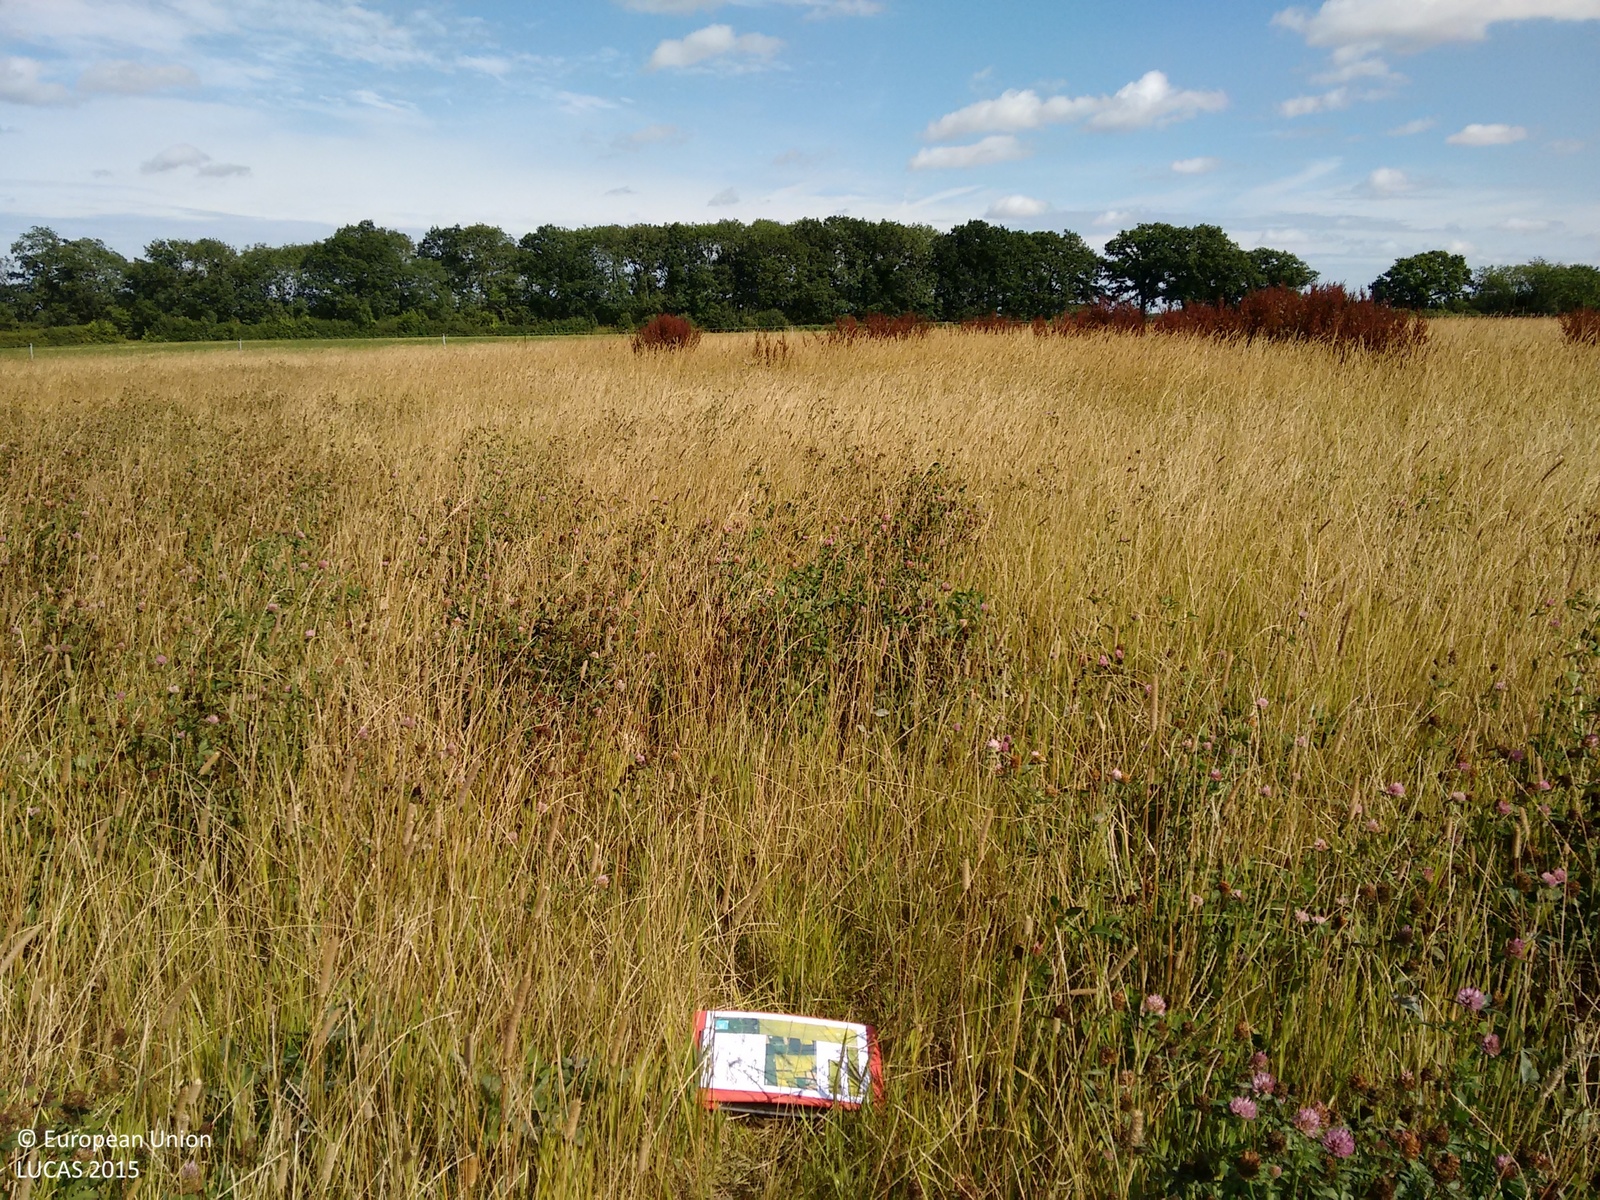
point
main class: Grassland
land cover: Grassland without tree/shrub cover
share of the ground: > 75 %
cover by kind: herbaceous plants 100 %
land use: Agriculture (excluding fallow land and kitchen gardens)
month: August
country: GB
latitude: 52.7417
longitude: 0.7768
